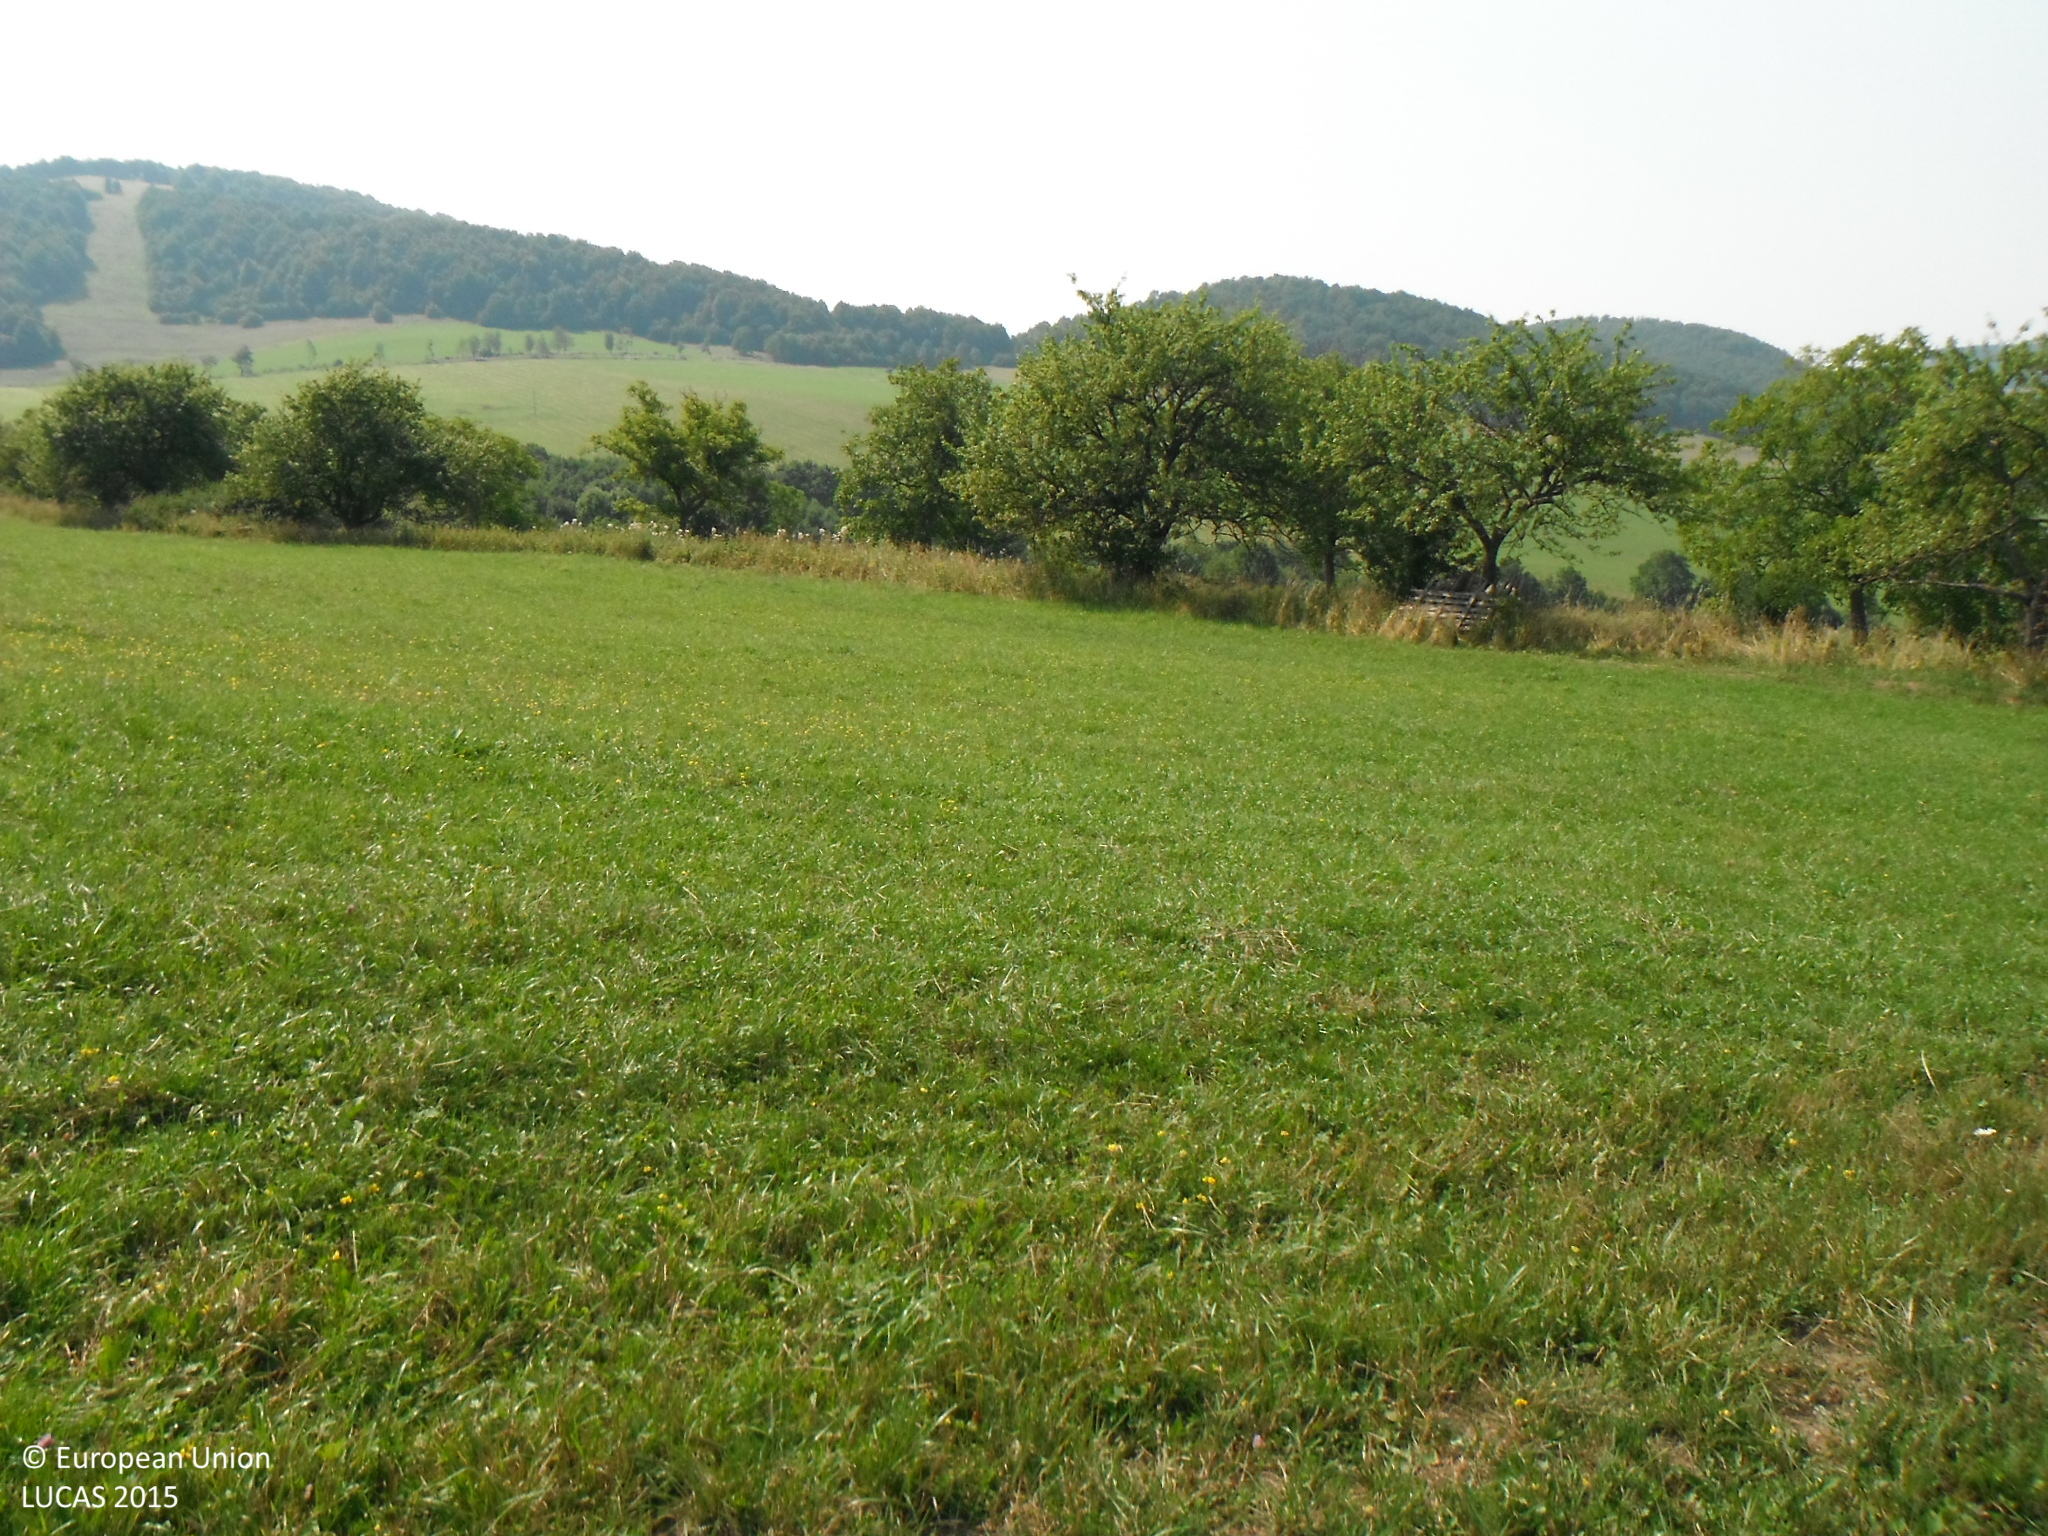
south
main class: Grassland
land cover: Grassland without tree/shrub cover
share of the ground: > 75 %
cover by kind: herbaceous plants 100 %
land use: Agriculture (excluding fallow land and kitchen gardens)
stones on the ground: 10 - 25 %
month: August
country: SK
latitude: 48.9485
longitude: 18.4423
